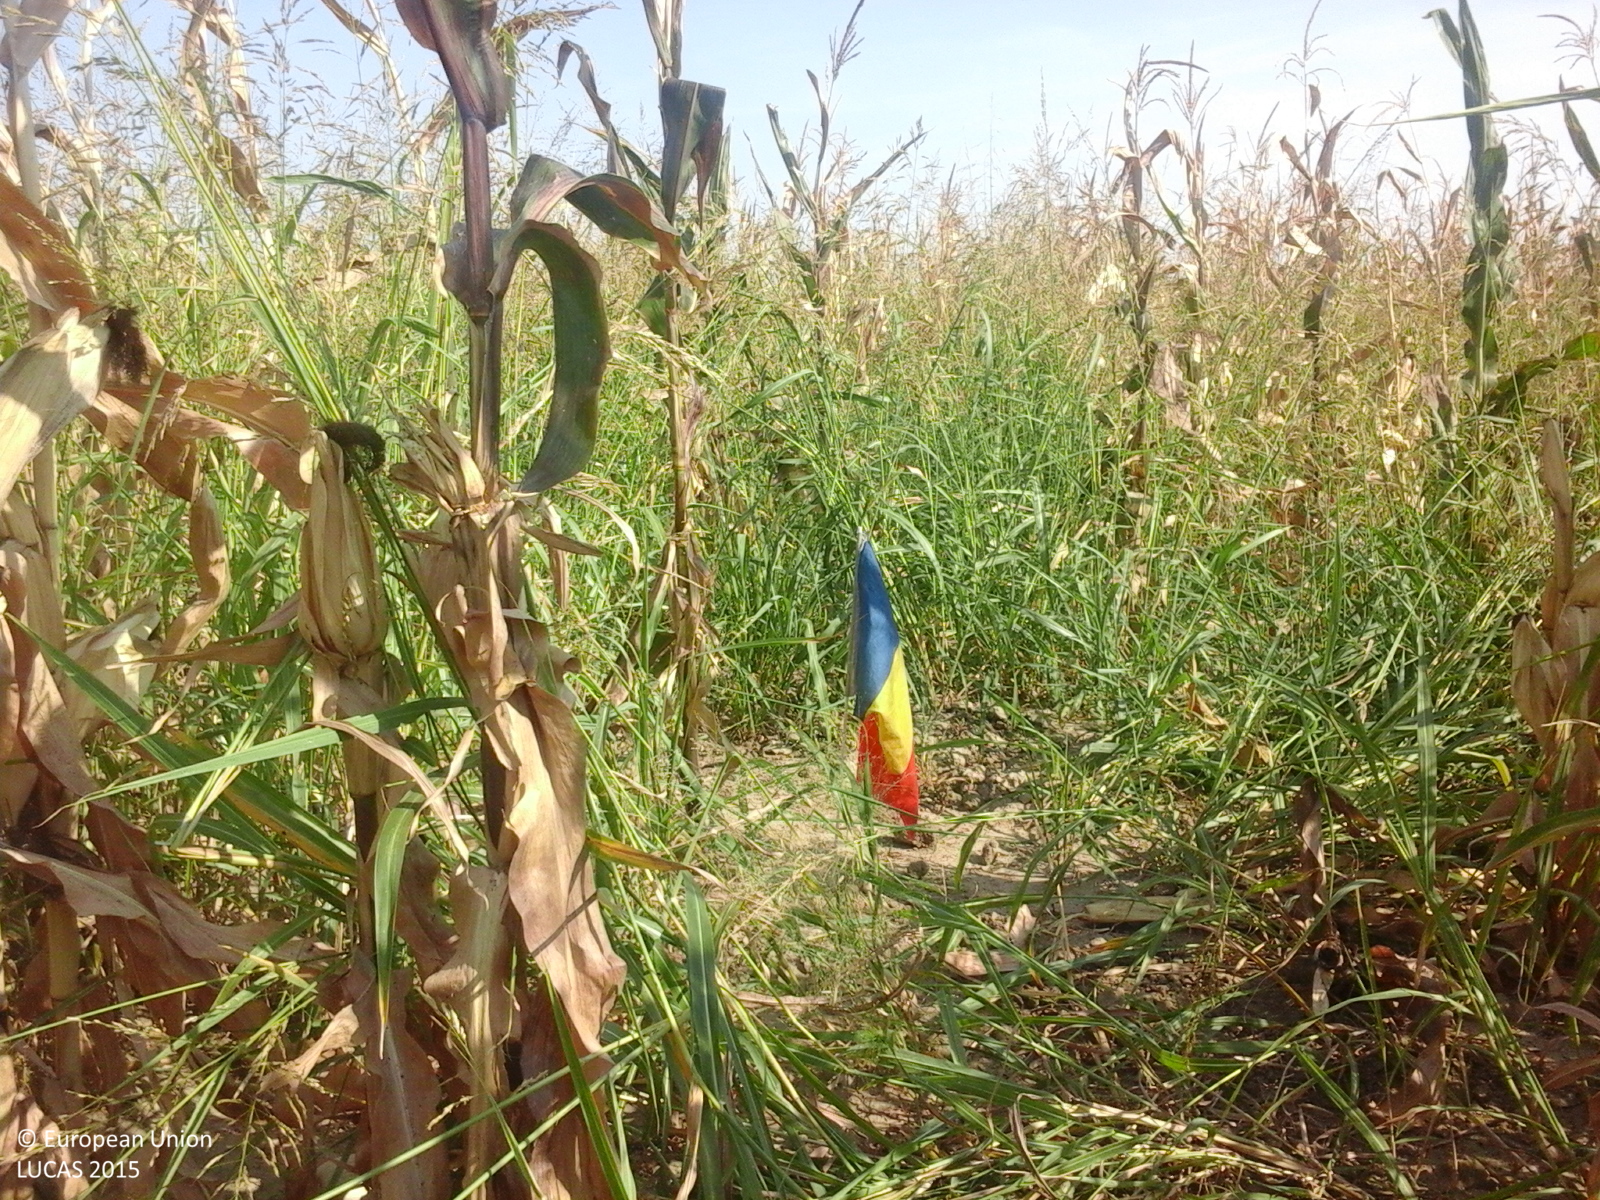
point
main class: Cropland
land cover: Maize
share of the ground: 50 - 75 %
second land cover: Spontaneously vegetated surfaces
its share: 50 - 75 %
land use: Agriculture (excluding fallow land and kitchen gardens)
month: August
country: RO
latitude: 43.8481
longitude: 23.4944
